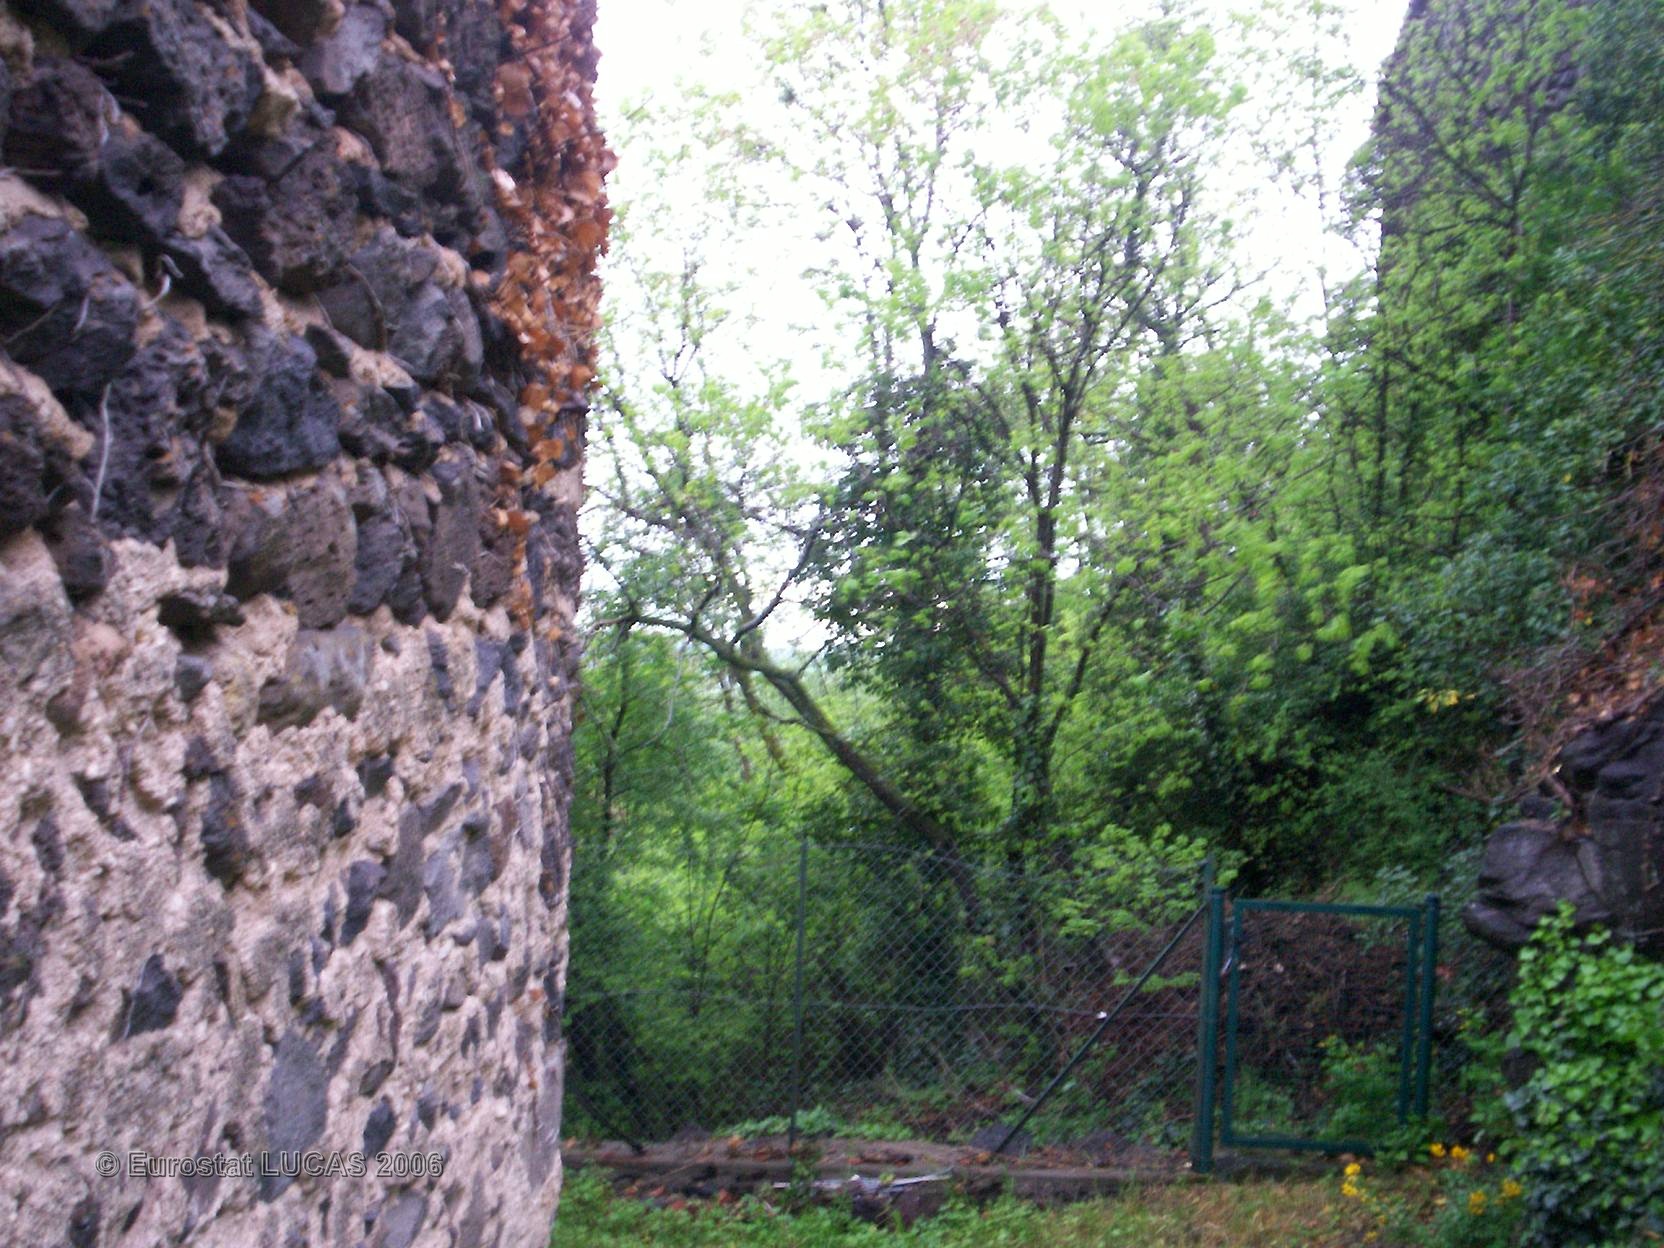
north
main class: Grassland
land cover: Grassland without tree/shrub cover
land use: Unused
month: May
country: FR
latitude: 45.4665
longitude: 3.2096
